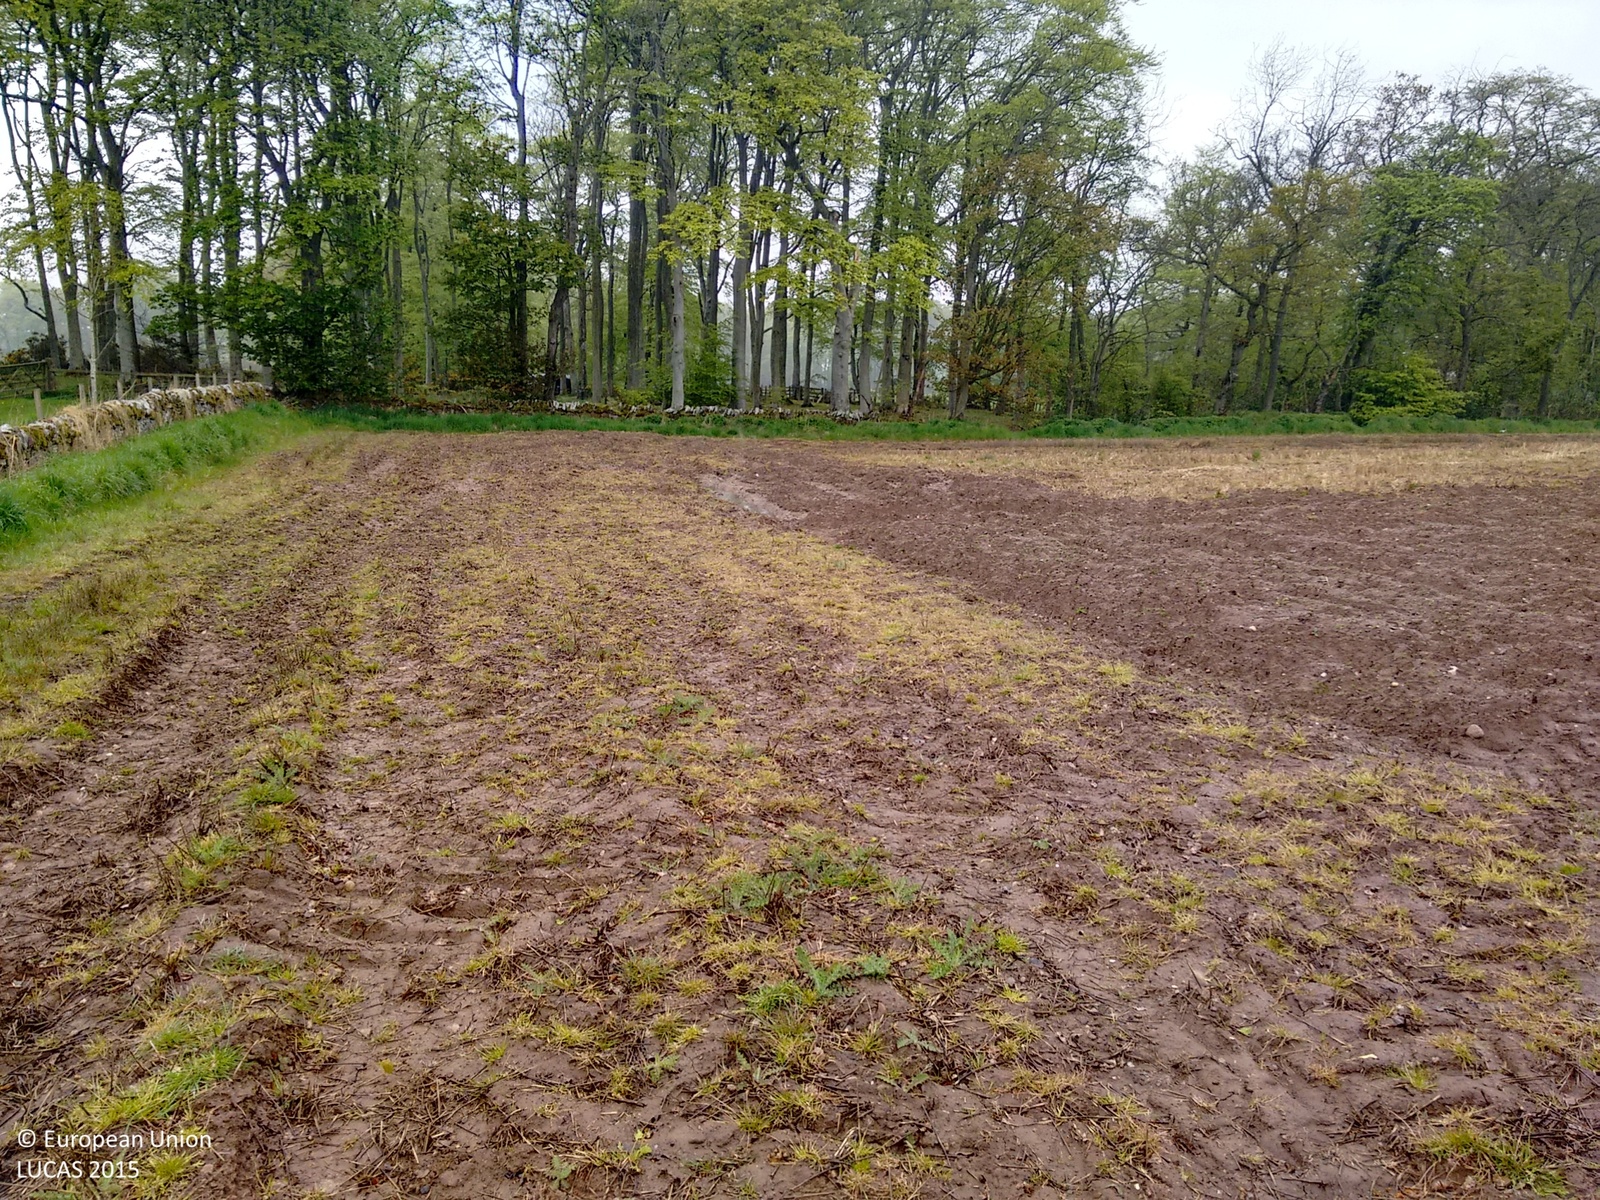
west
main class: Grassland
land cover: Spontaneously vegetated surfaces
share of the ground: 10 - 25 %
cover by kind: unconsolidated bare surface 60 %, herbaceous plants 40 %
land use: Agriculture (excluding fallow land and kitchen gardens)
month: May
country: GB
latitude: 56.6070
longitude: -2.5531
